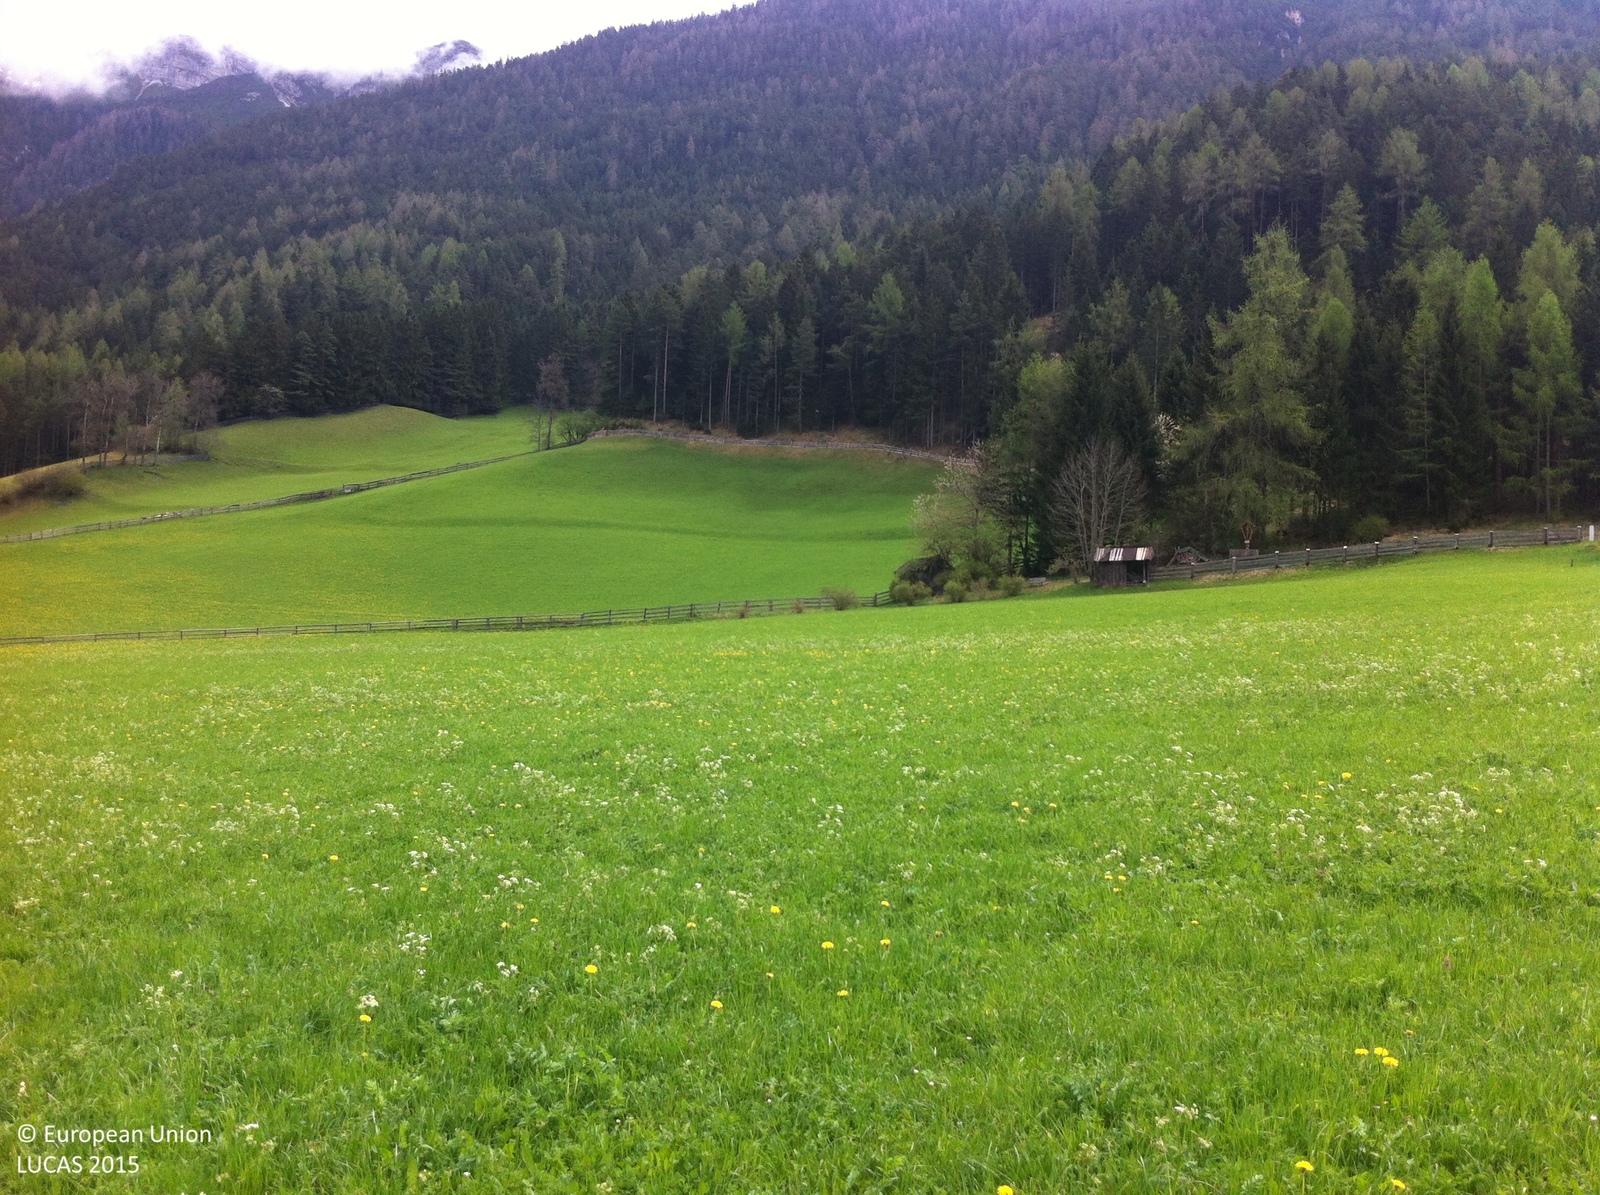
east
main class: Grassland
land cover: Grassland without tree/shrub cover
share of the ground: > 75 %
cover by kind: herbaceous plants 100 %
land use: Agriculture (excluding fallow land and kitchen gardens)
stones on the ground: < 10 %
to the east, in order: Grassland without tree/shrub cover; Paved roads, cycling and walking lanes; Fences; Grassland without tree/shrub cover
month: May
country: AT
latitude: 47.1174
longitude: 11.3299
